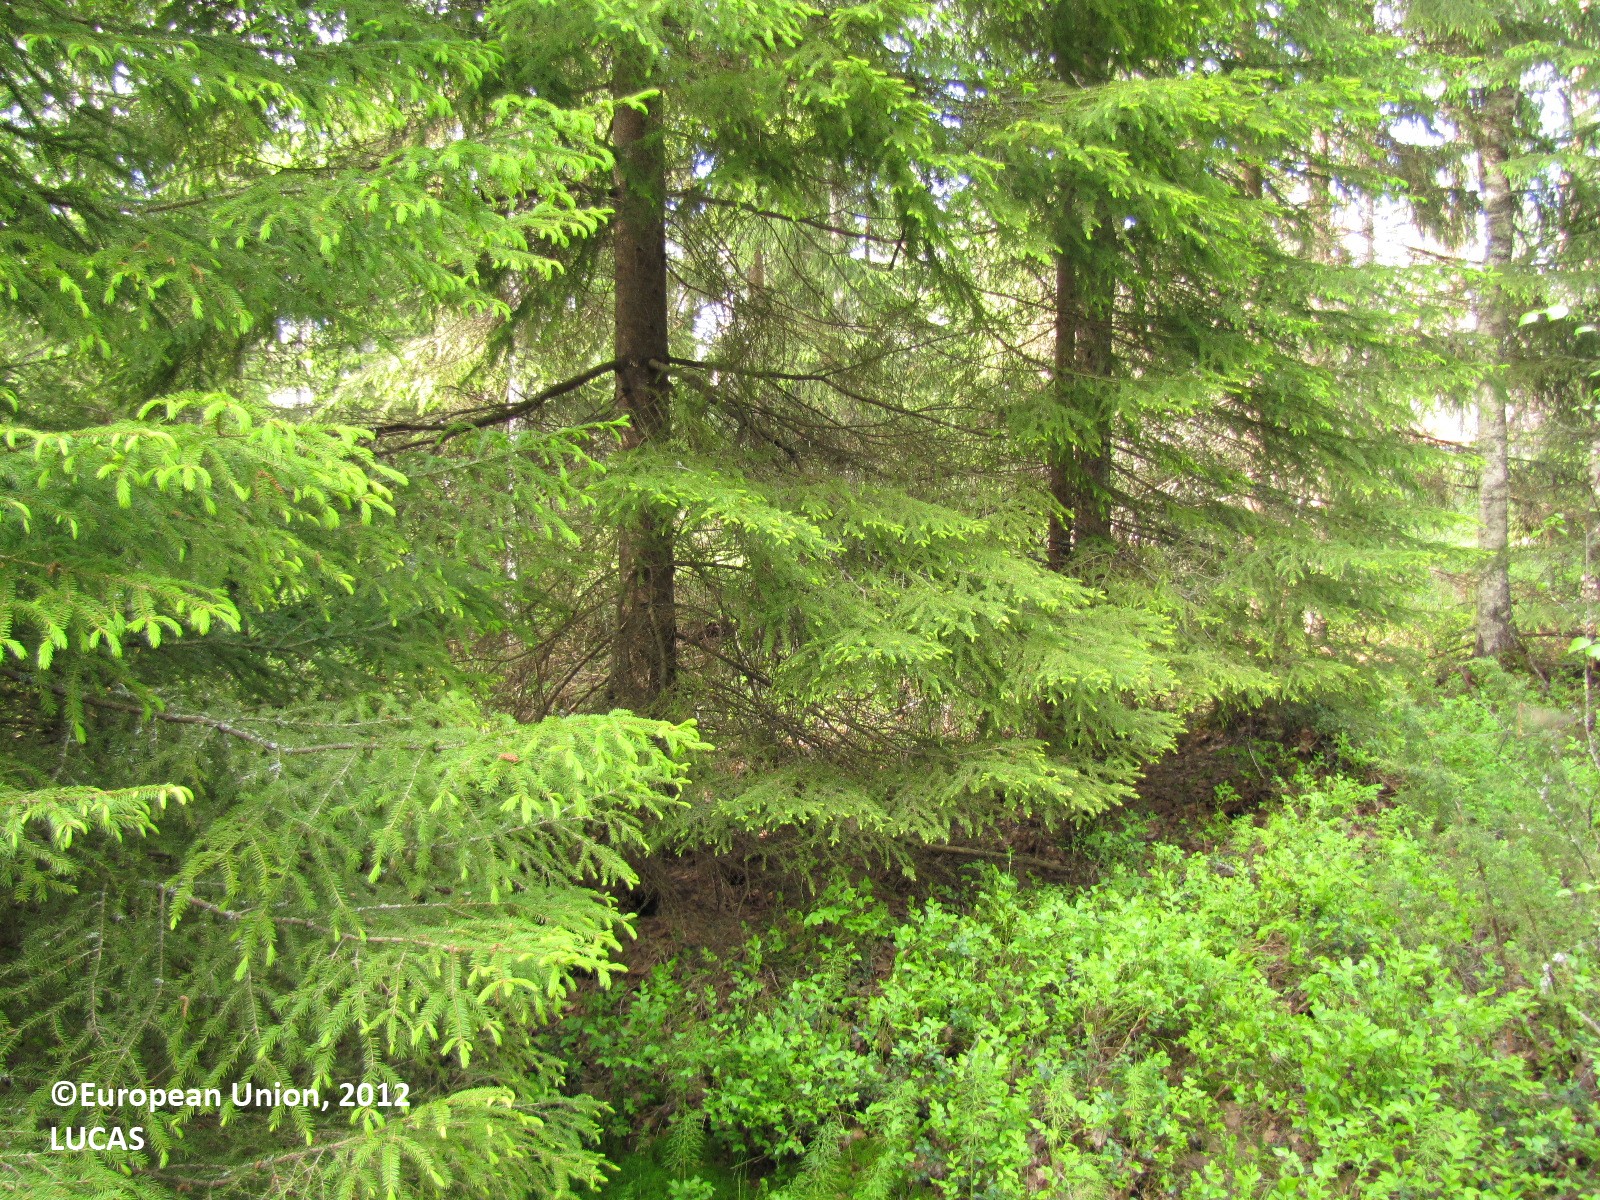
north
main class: Woodland
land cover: Other mixed woodland
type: boreal forest
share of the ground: > 75 %
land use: Forestry
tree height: > 5 m
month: June
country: FI
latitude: 61.4566
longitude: 23.0355
